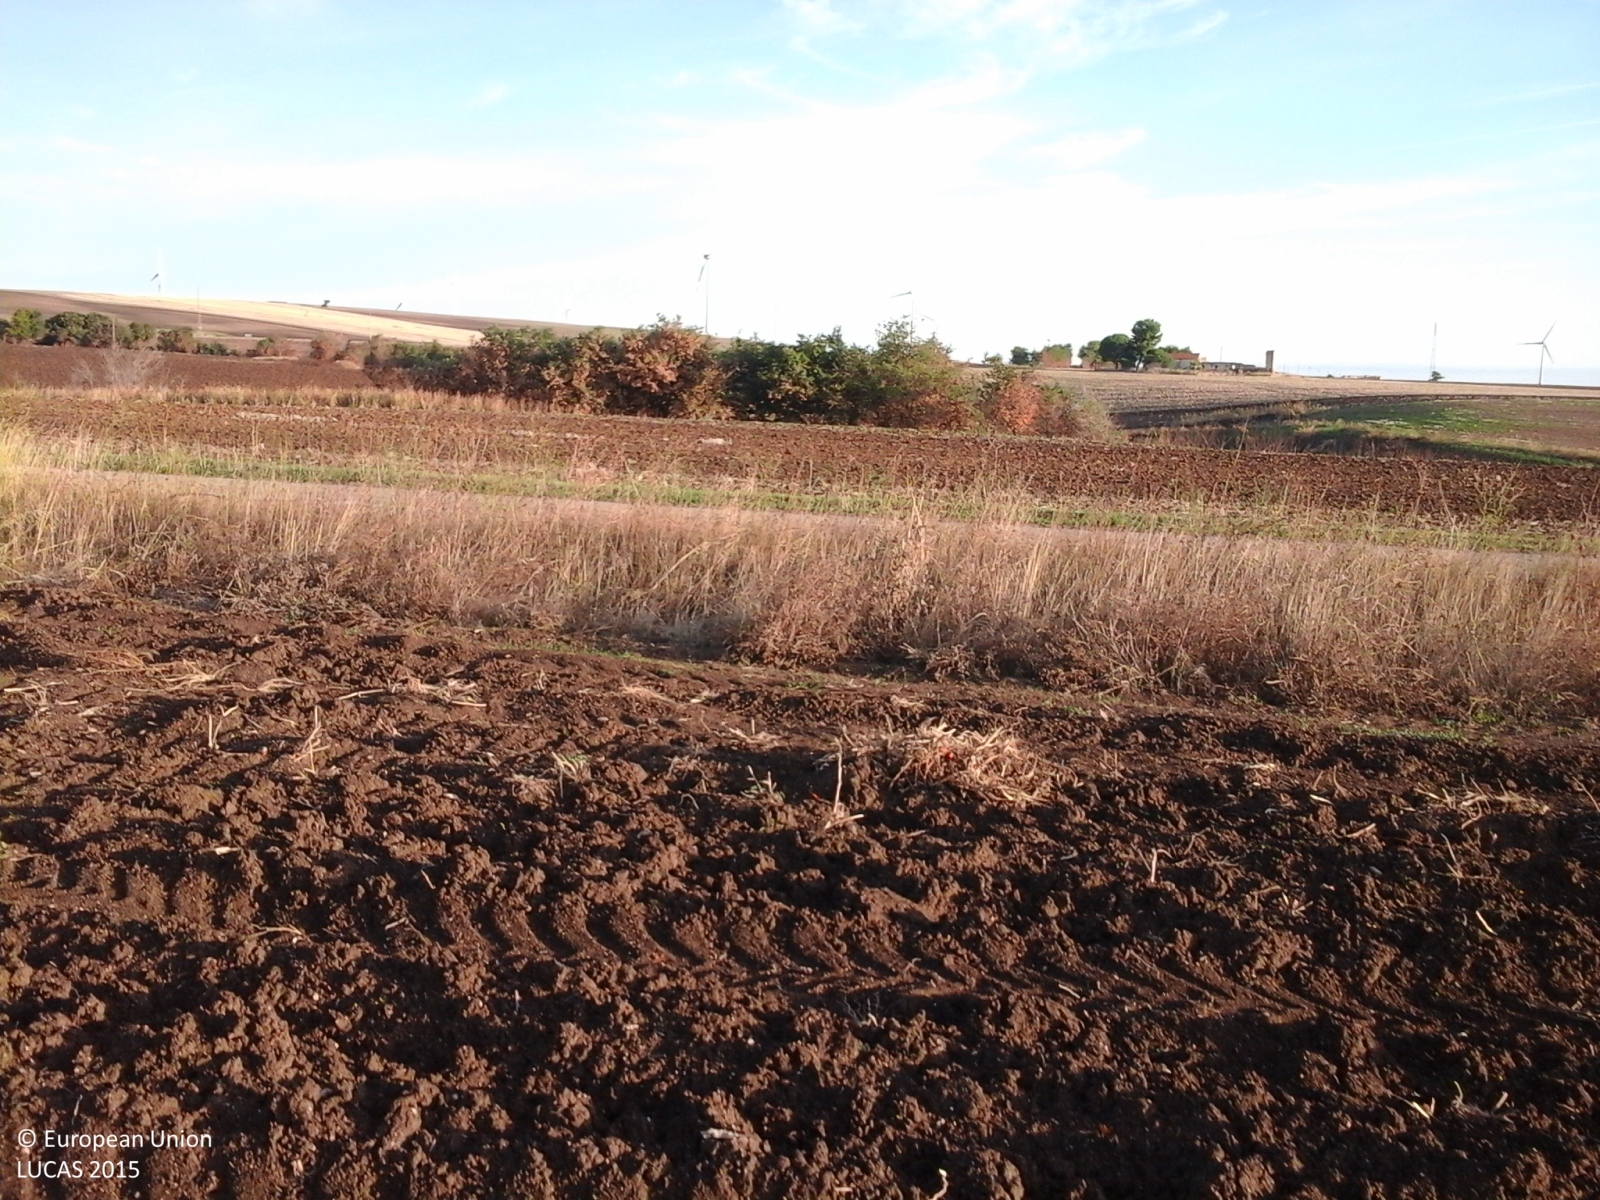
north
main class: Cropland
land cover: Tomatoes
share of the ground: > 75 %
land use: Agriculture (excluding fallow land and kitchen gardens)
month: October
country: IT
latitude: 41.8496
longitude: 15.2233
